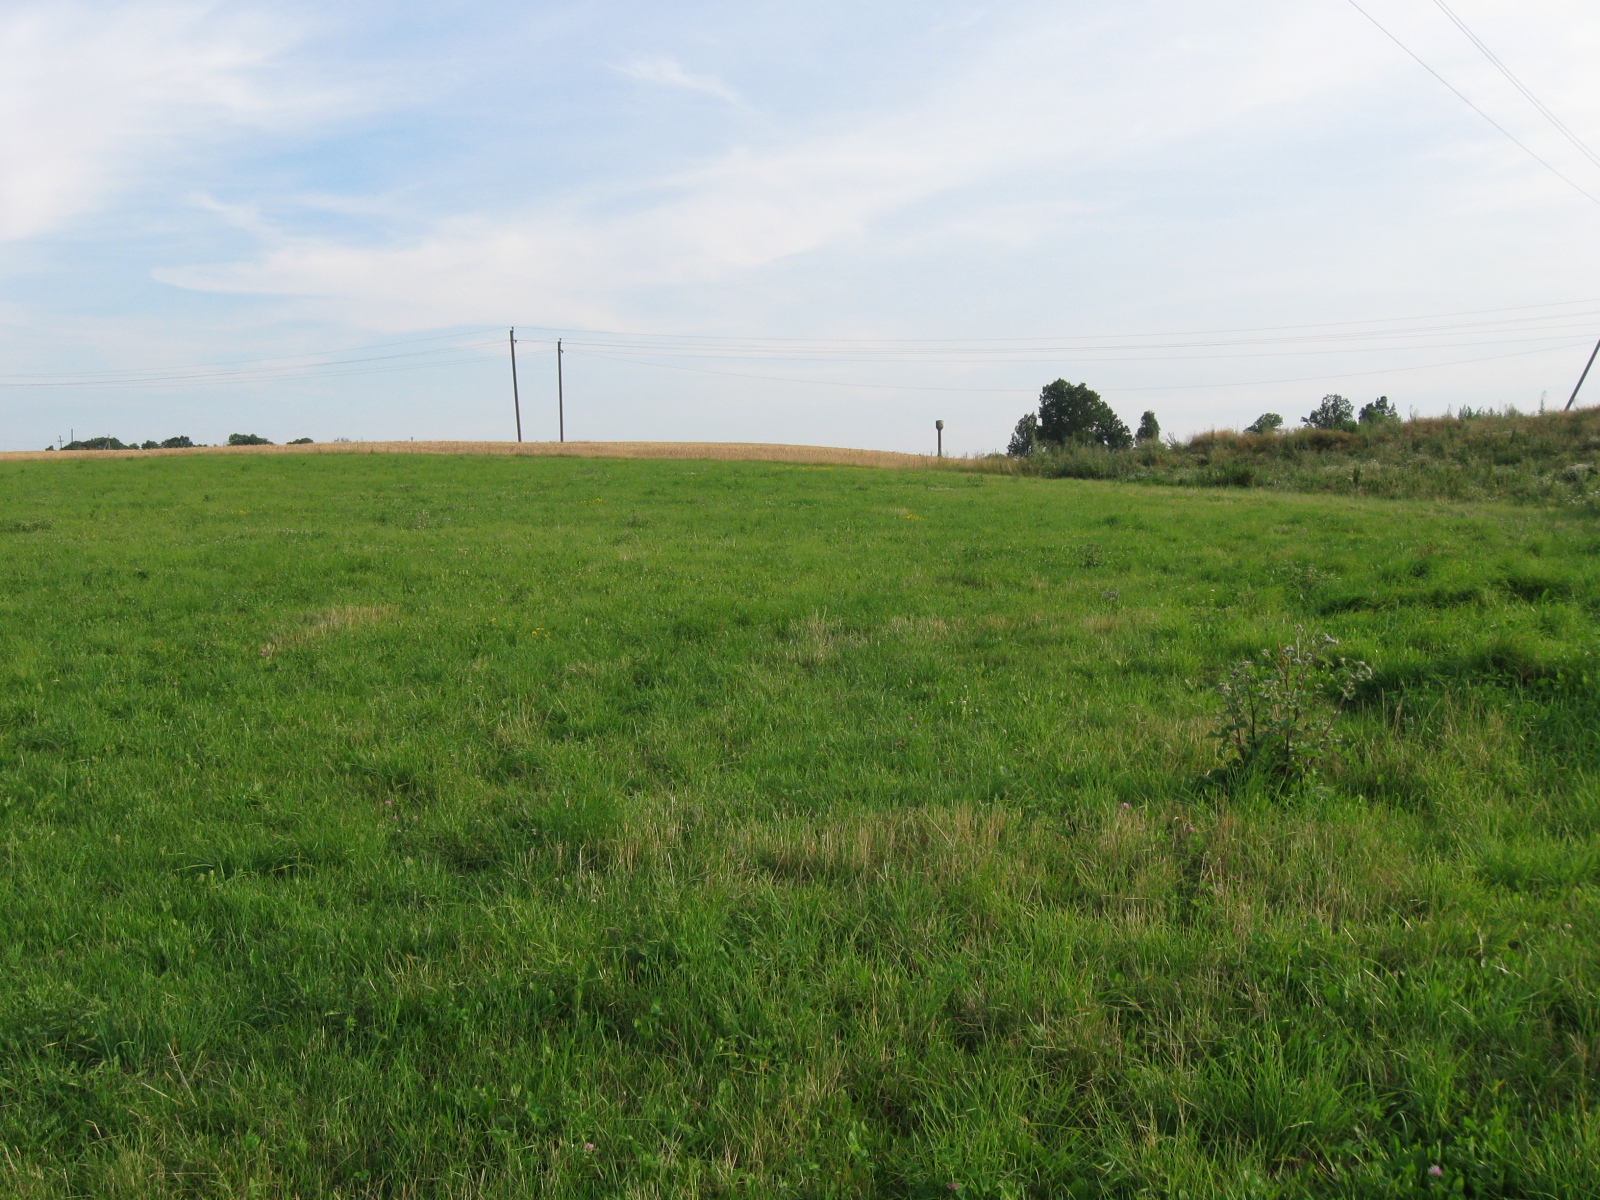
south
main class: Grassland
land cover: Grassland without tree/shrub cover
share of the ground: > 75 %
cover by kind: herbaceous plants 100 %
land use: Agriculture (excluding fallow land and kitchen gardens)
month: July
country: LT
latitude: 54.6723
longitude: 23.7795
